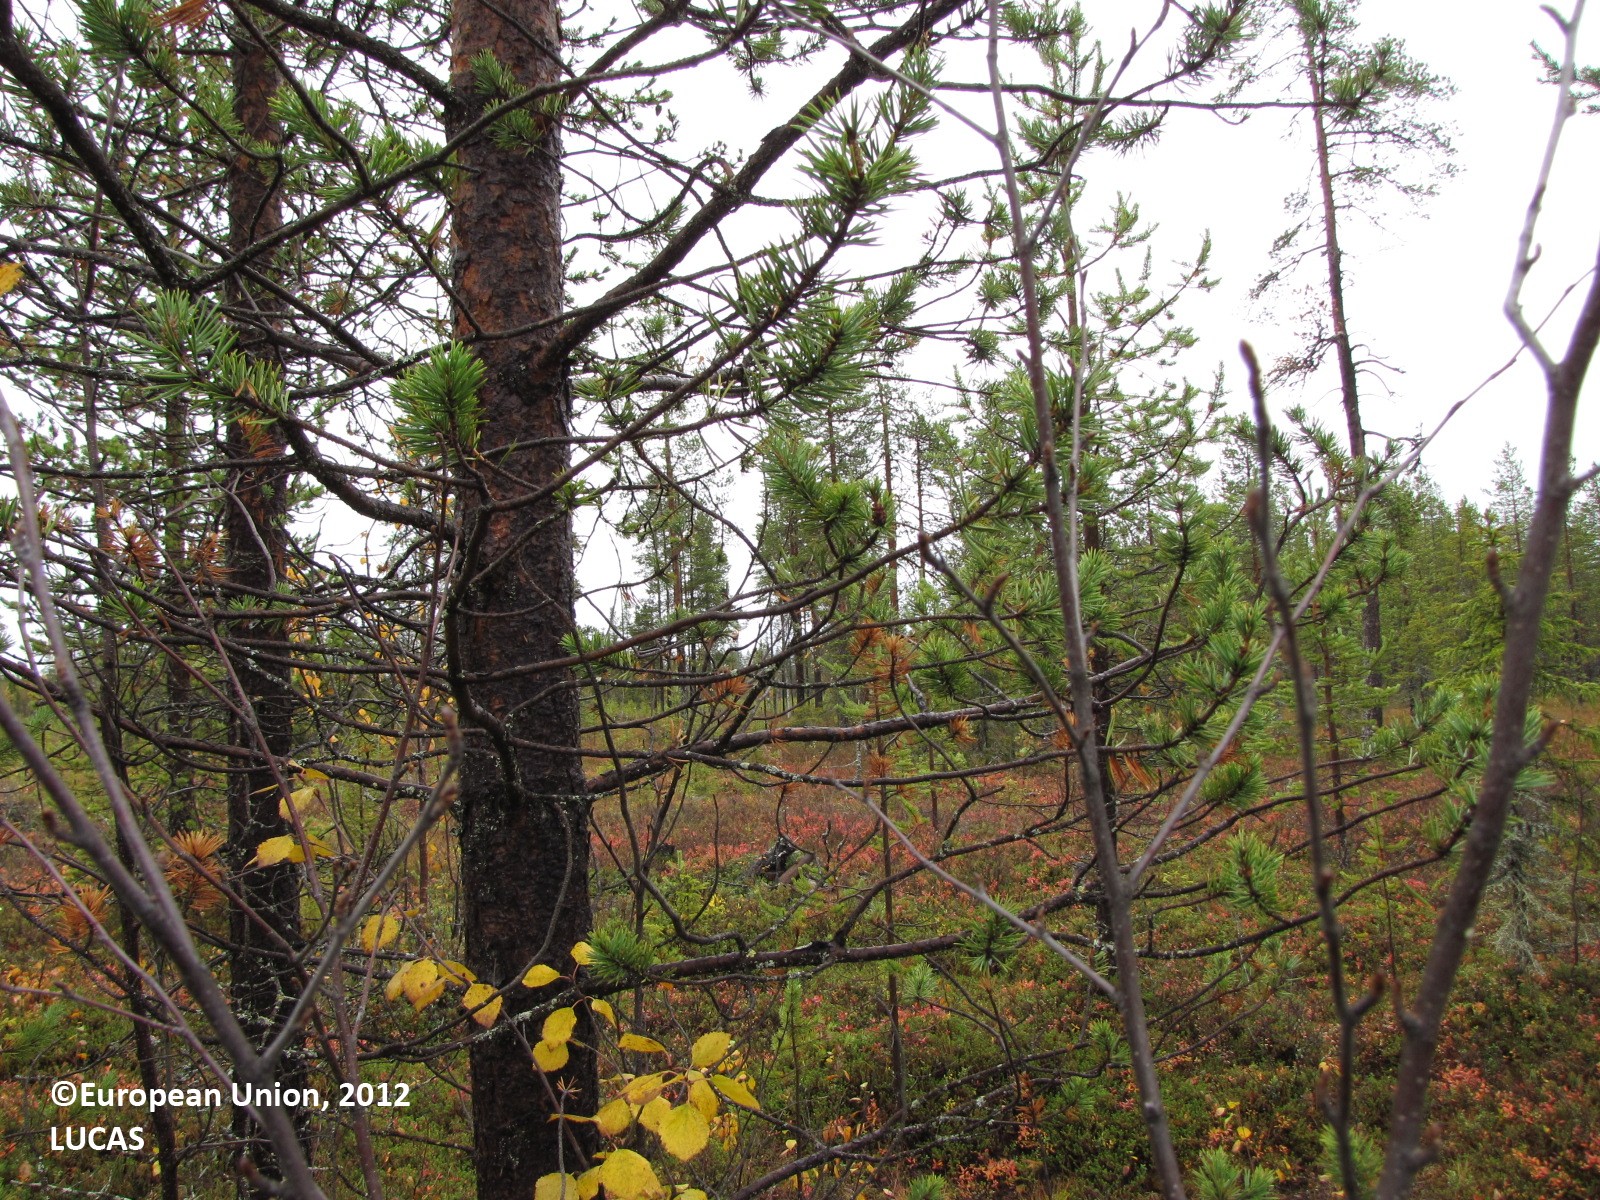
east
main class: Woodland
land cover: Other coniferous woodland
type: boreal forest
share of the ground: 25 - 50 %
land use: Forestry
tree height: > 5 m
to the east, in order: Other coniferous woodland; Spruce dominated coniferous woodland
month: September
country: FI
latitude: 67.4368
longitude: 25.3916
